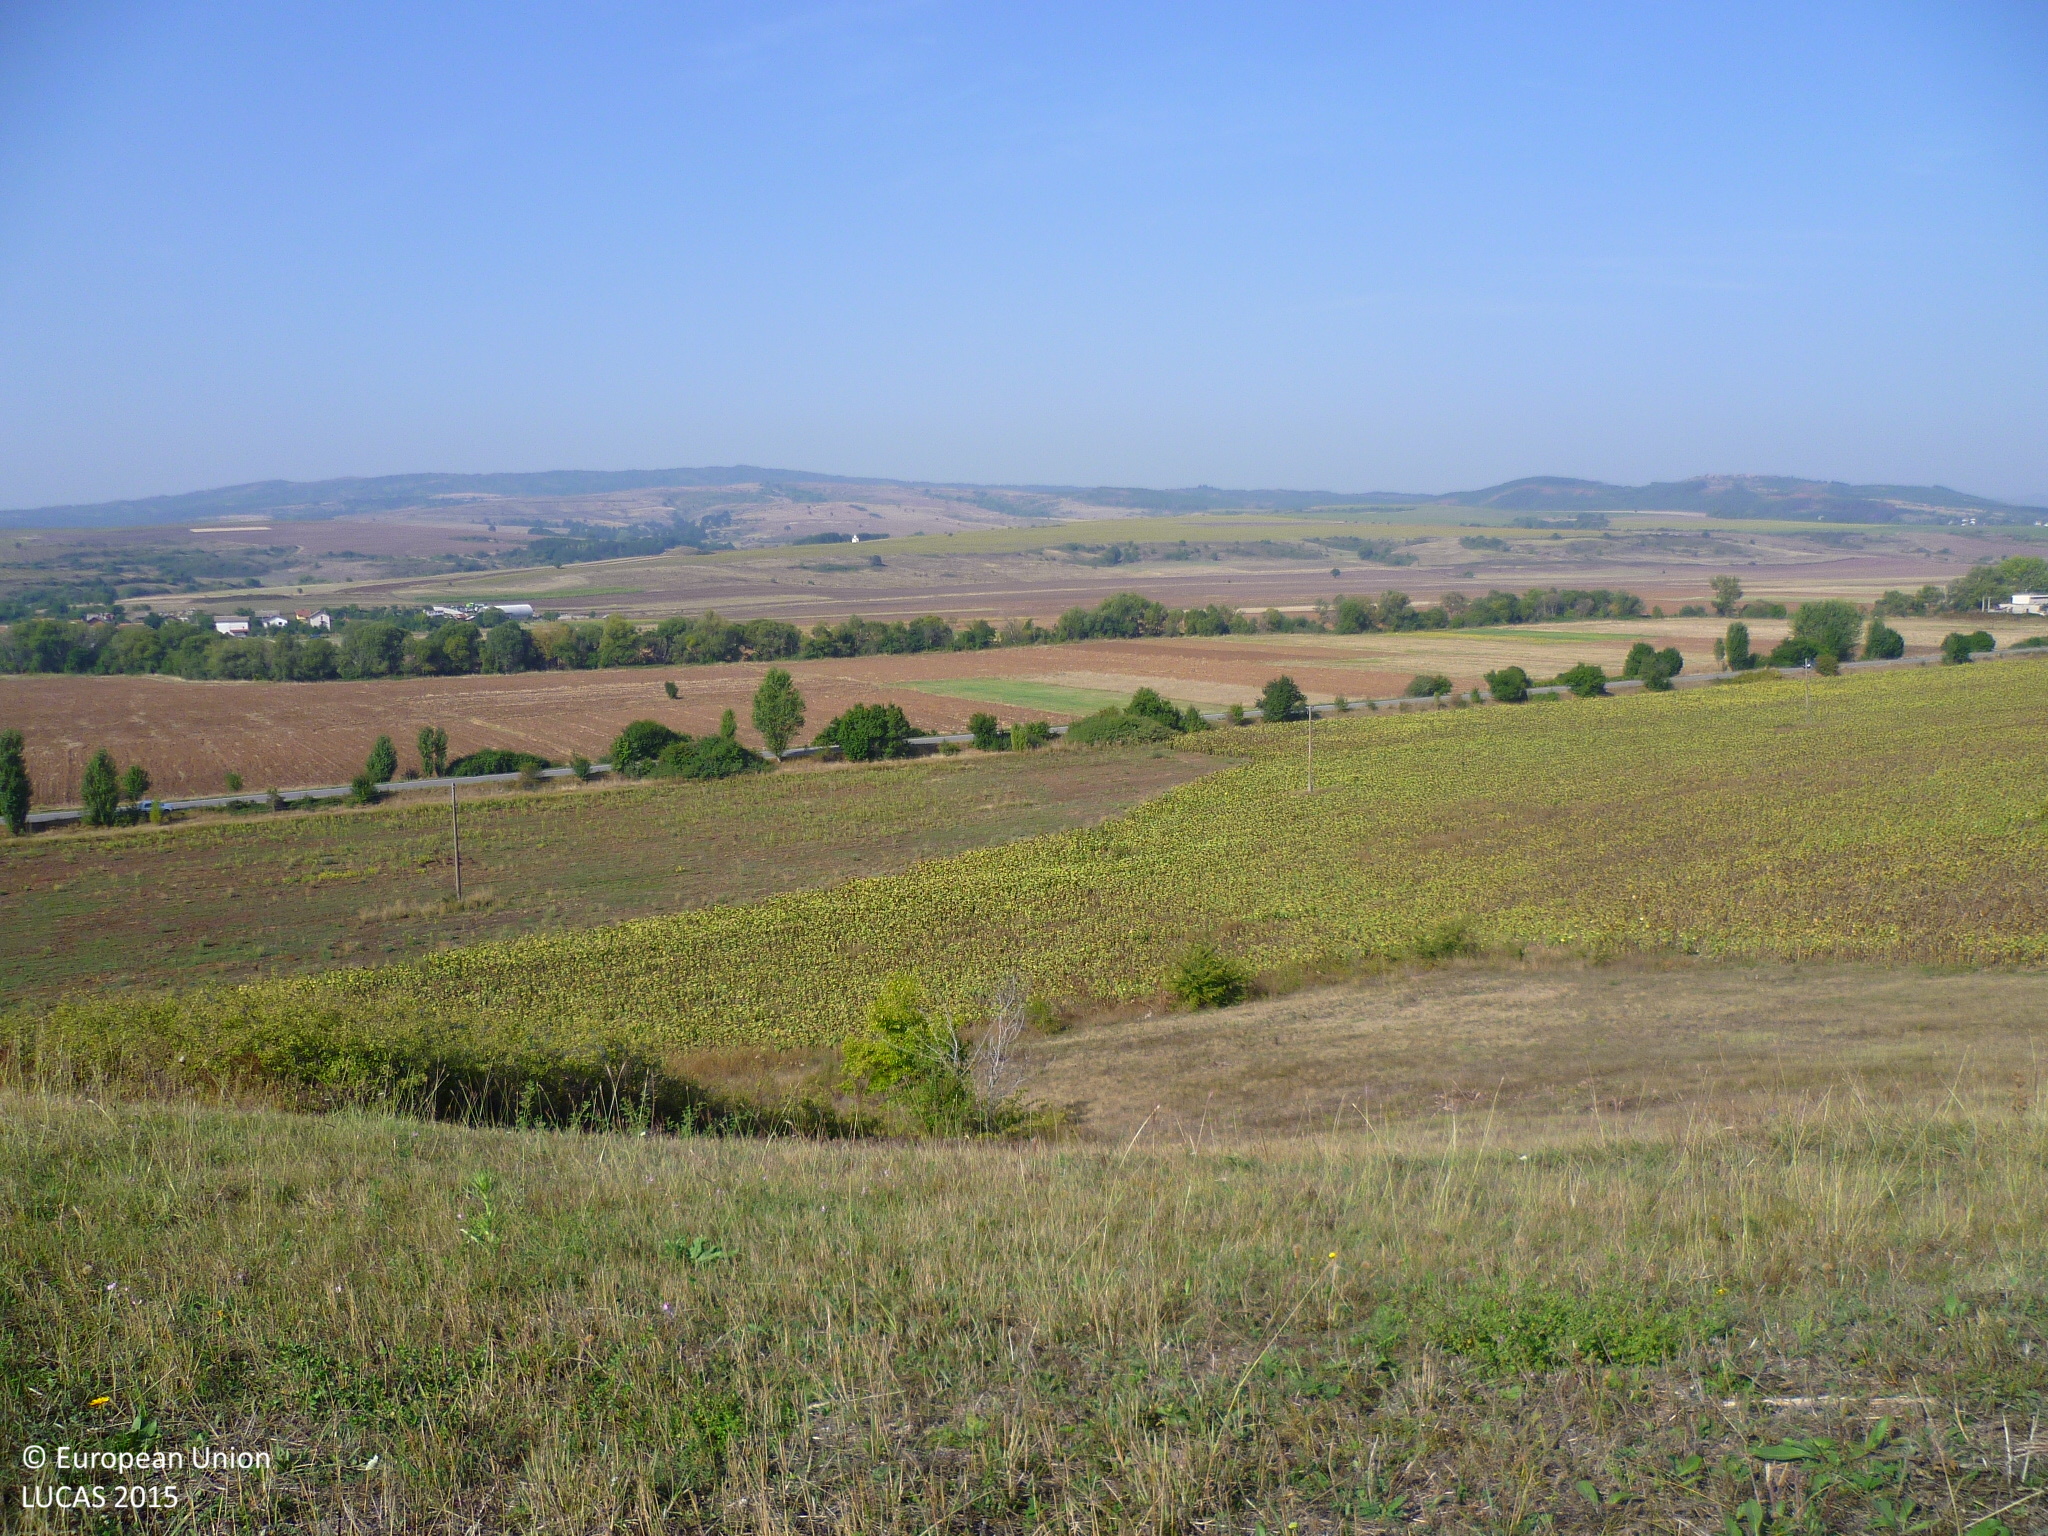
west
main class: Grassland
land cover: Grassland without tree/shrub cover
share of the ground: > 75 %
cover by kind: herbaceous plants 100 %
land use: Agriculture (excluding fallow land and kitchen gardens)
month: September
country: BG
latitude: 42.6415
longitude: 22.9441
